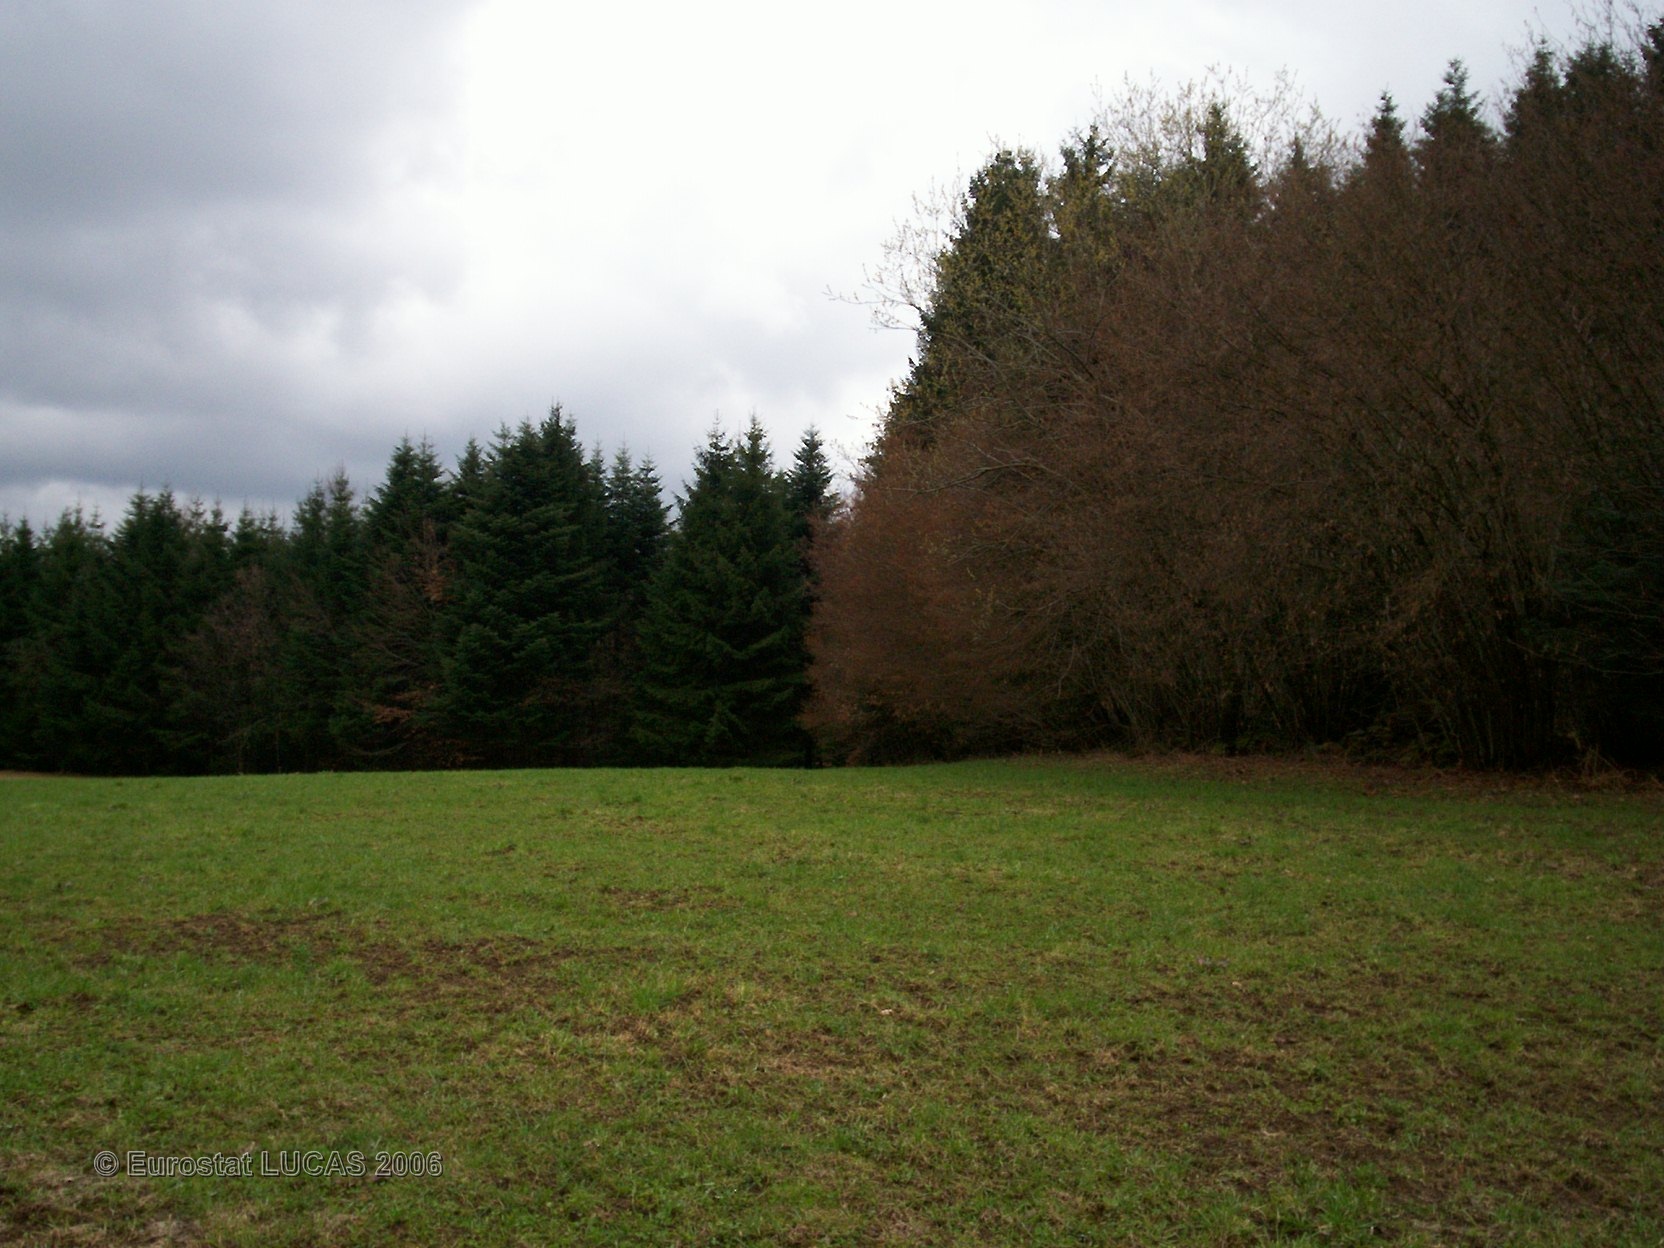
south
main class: Grassland
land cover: Grassland without tree/shrub cover
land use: Agriculture (excluding fallow land and kitchen gardens)
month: April
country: FR
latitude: 47.9521
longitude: 6.5062
